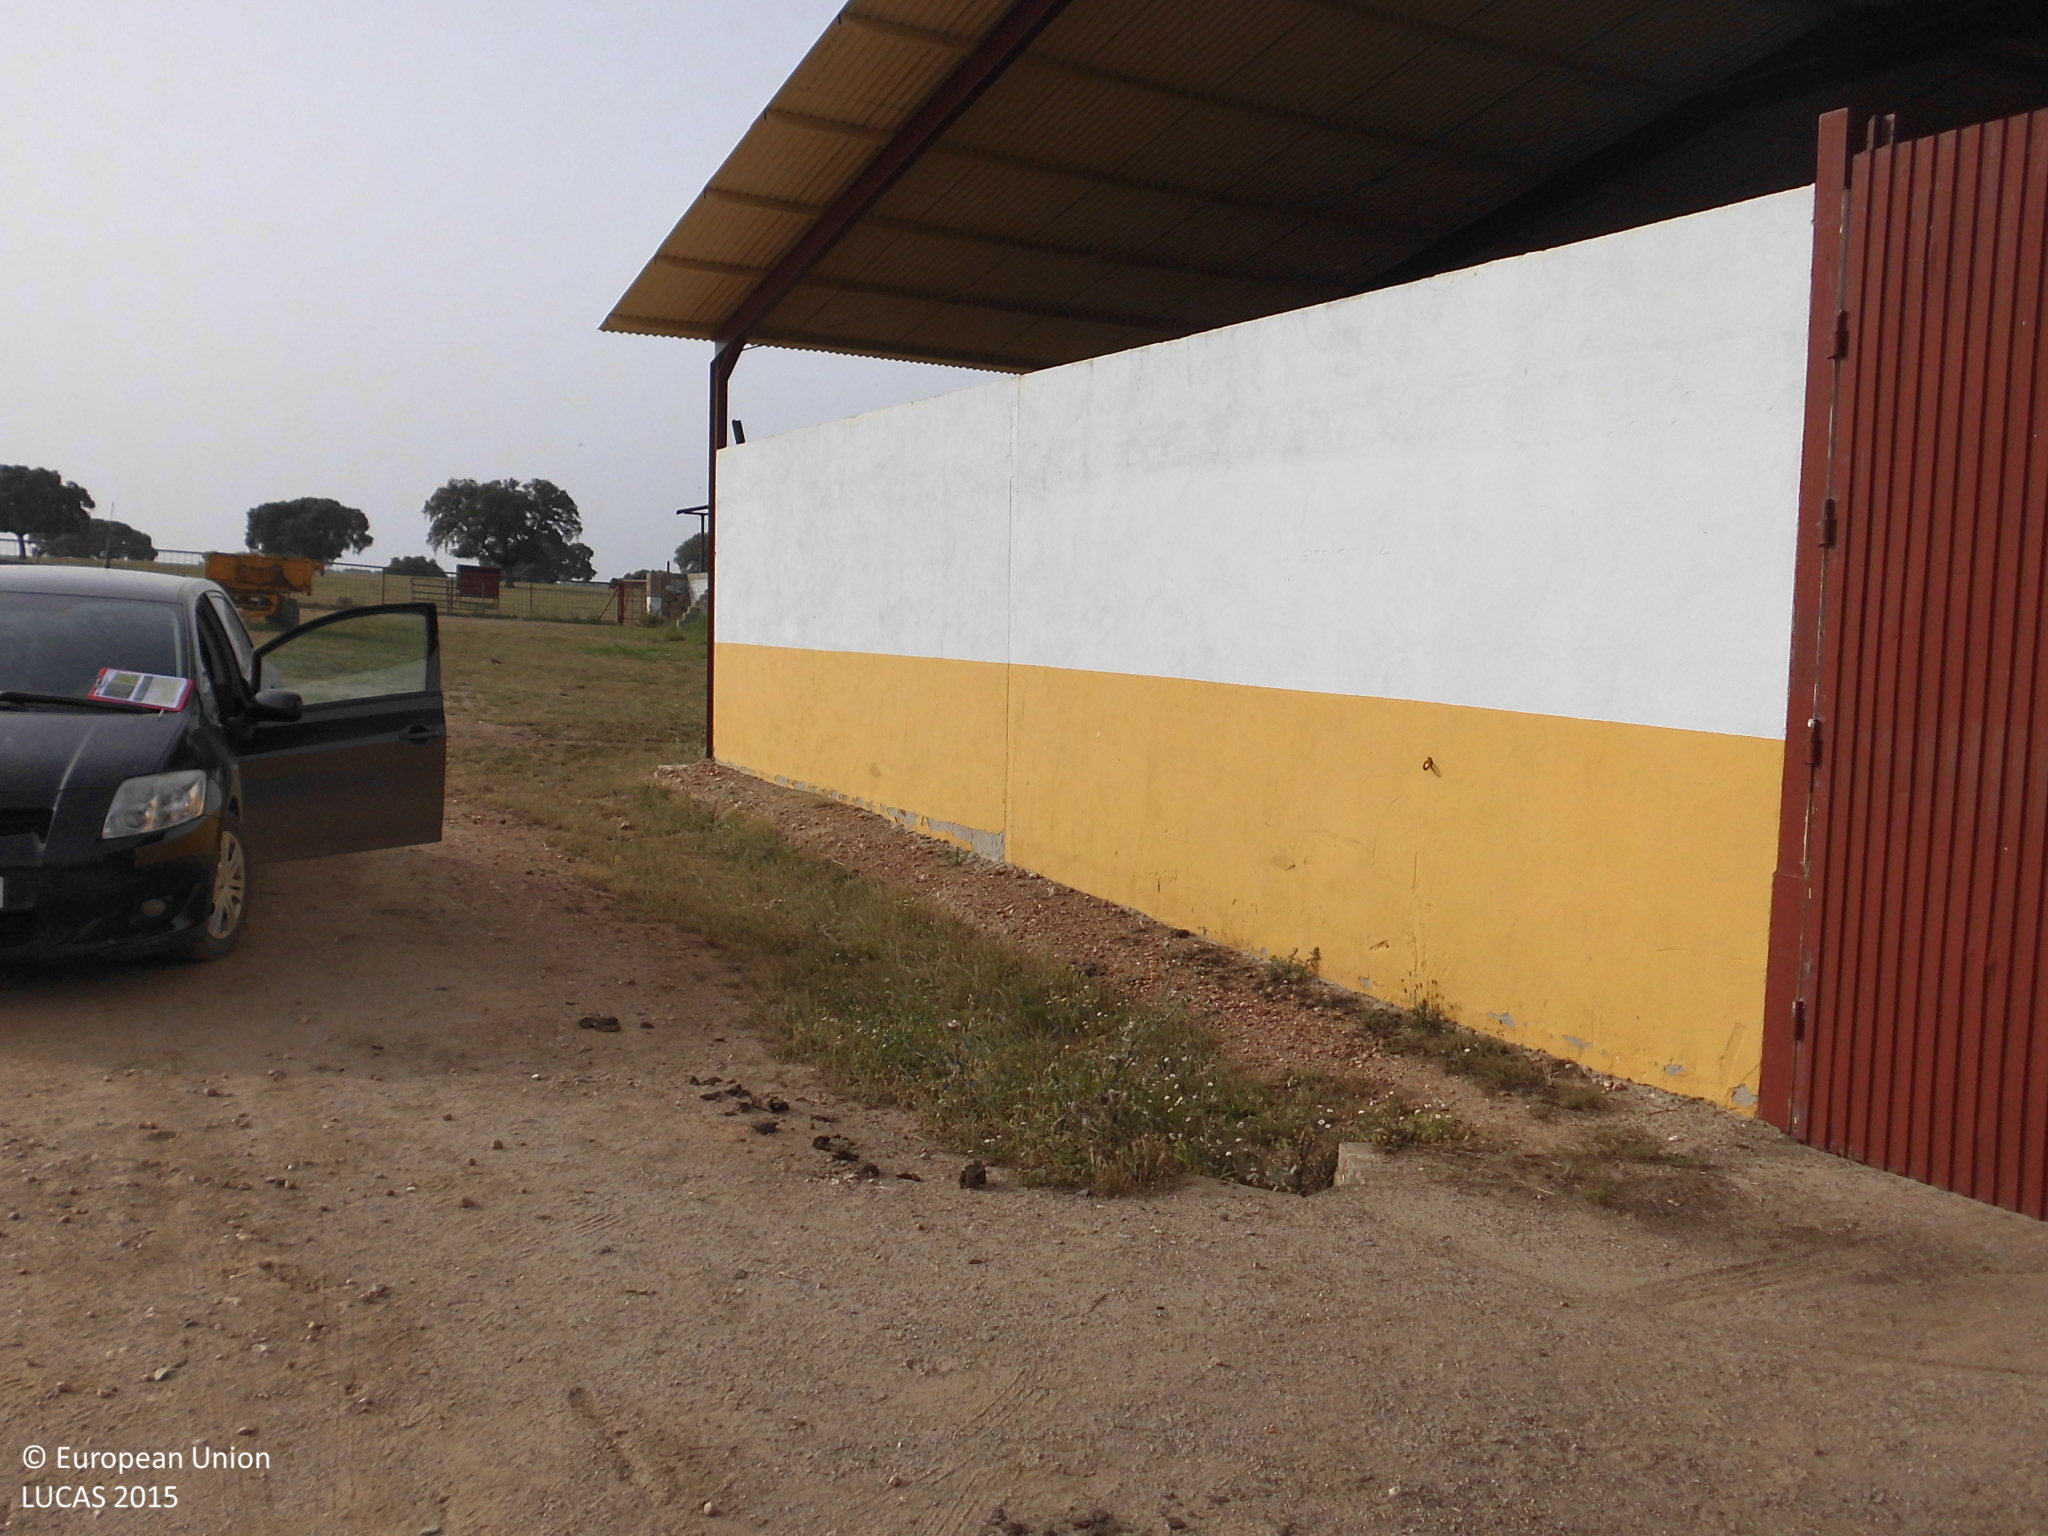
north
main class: Woodland
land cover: Broadleaved woodland
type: broadleaved evergreen forest
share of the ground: 10 - 25 %
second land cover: Grassland without tree/shrub cover
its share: > 75 %
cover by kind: shrubs 45 %, herbaceous plants 45 %, broadleaved forest trees 10 %
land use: Semi-natural and natural areas not in use
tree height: > 5 m
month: May
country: ES
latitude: 39.6046
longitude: -6.1256
